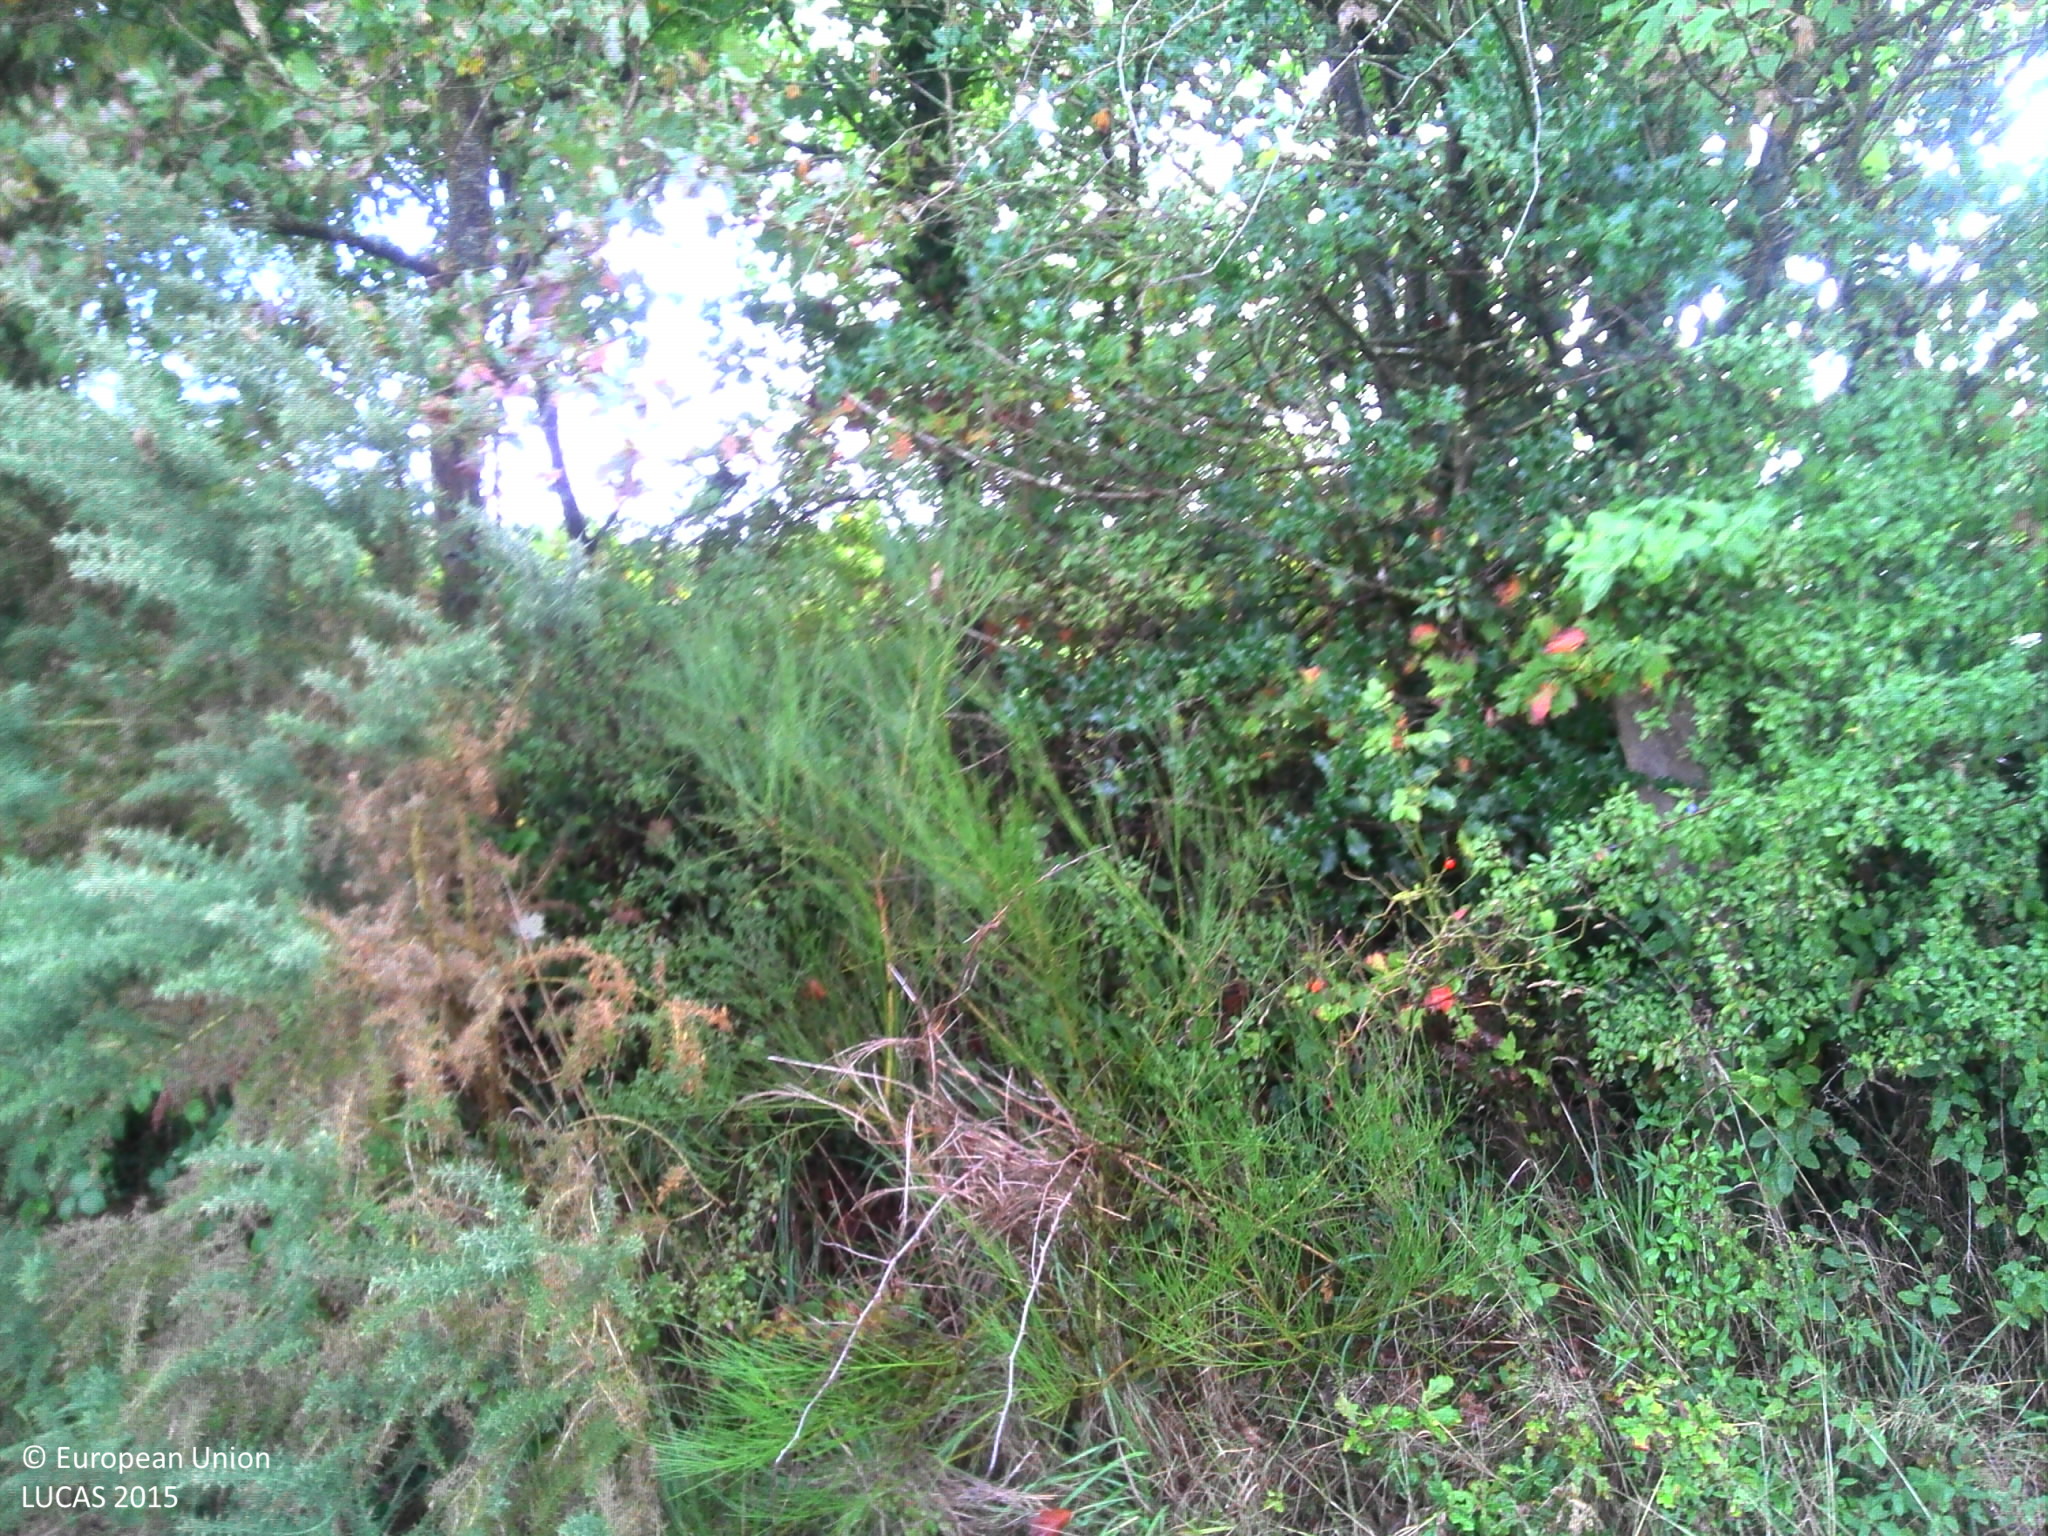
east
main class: Cropland
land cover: Temporary grasslands
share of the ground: > 75 %
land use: Agriculture (excluding fallow land and kitchen gardens)
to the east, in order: Temporary grasslands; Fences; Broadleaved woodland; Ditches and canals; Grass margins; Tracks; Grass margins; Broadleaved woodland; Fences; Broadleaved woodland; Fences; Grassland without tree/shrub cover; Fences; Broadleaved woodland; Fences; Broadleaved woodland; Paved roads, cycling and walking lanes; Broadleaved woodland; Fences; Grassland without tree/shrub cover
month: September
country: FR
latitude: 46.6195
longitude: -1.3323
